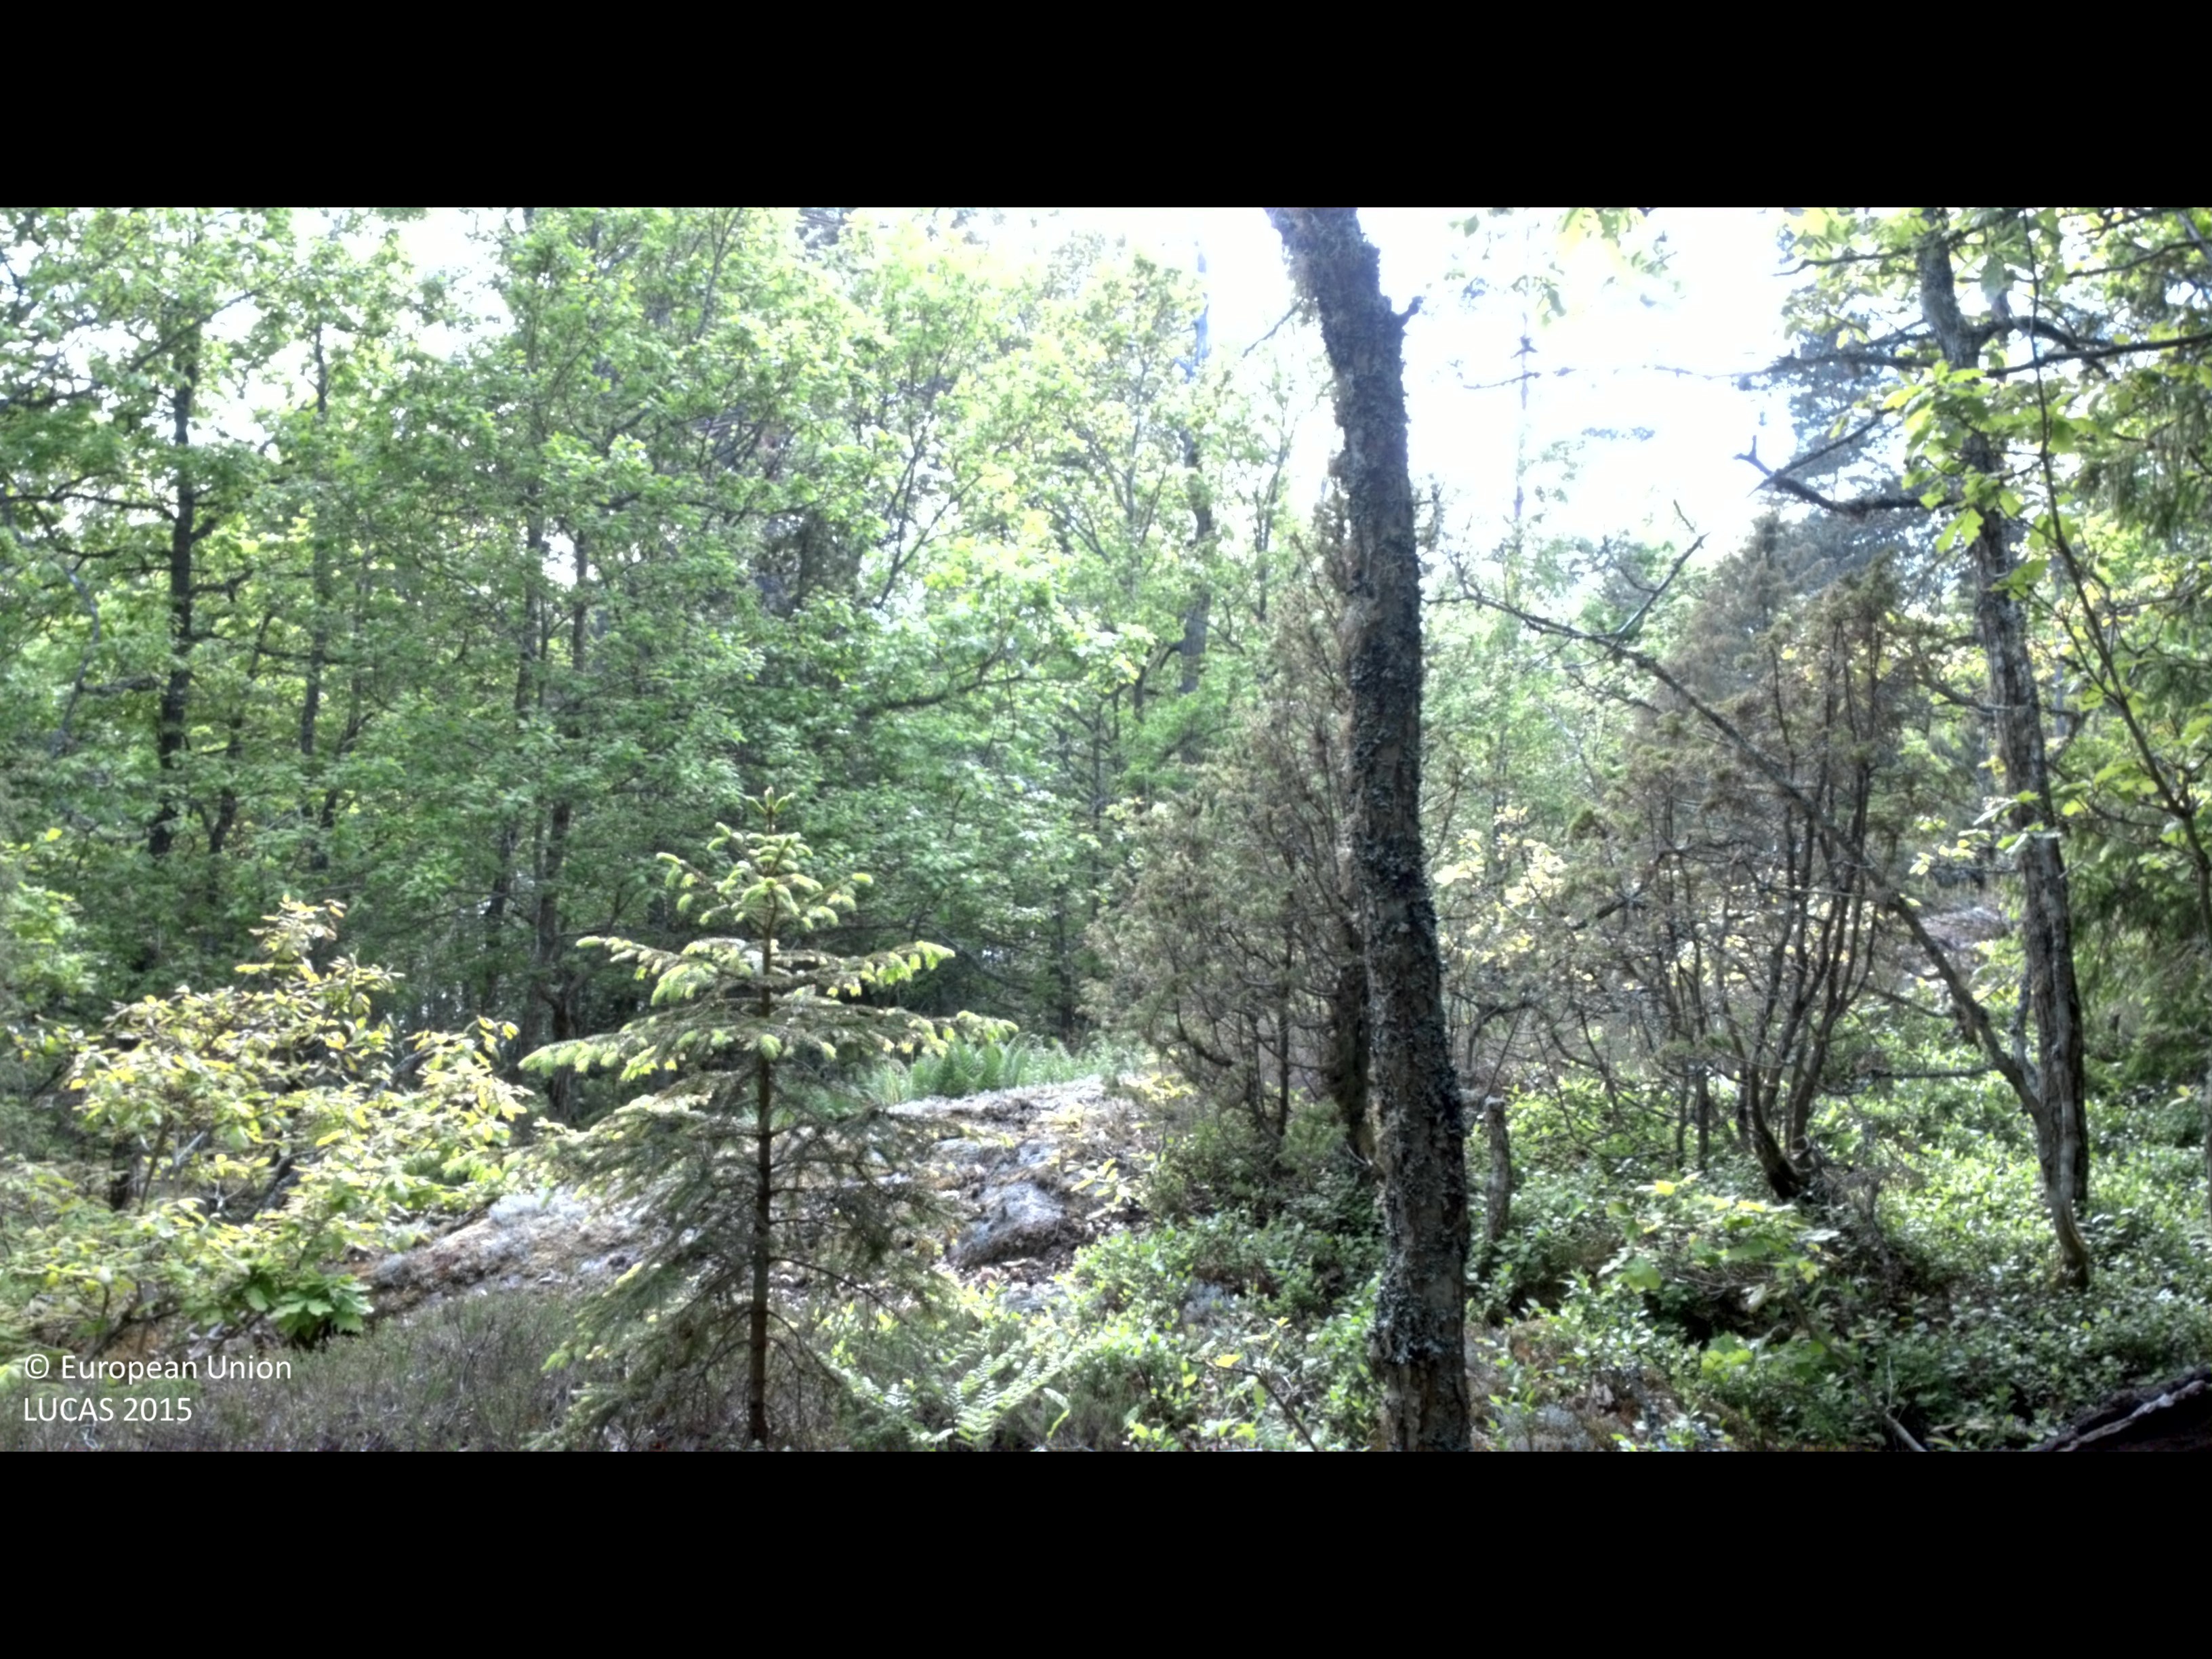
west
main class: Woodland
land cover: Spruce dominated mixed woodland
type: boreal forest
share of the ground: > 75 %
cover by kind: coniferous forest trees 45 %, broadleaved forest trees 40 %, shrubs 10 %, consolidated bare surface 5 %
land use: Forestry
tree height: > 5 m
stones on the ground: 10 - 25 %
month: May
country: SE
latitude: 57.4852
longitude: 16.4879
